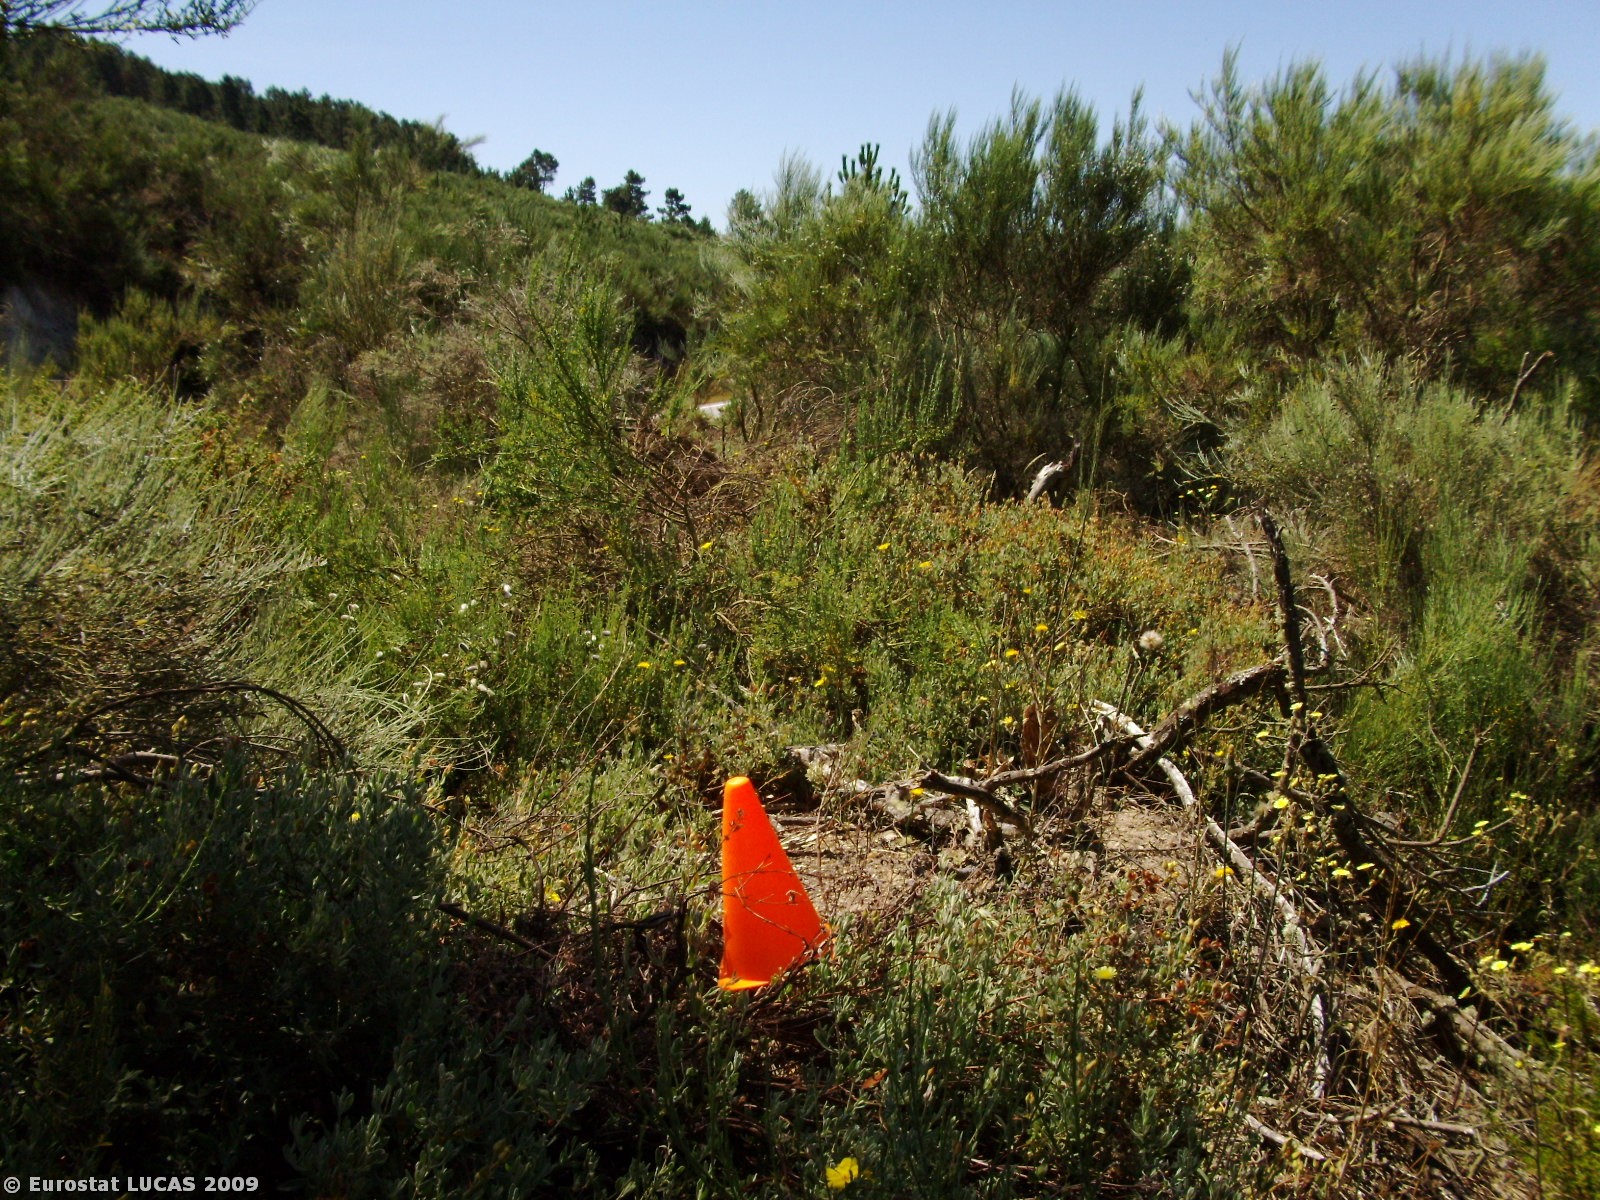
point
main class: Woodland
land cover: Coniferous woodland
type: coniferous forest of the mediterranean region
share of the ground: 25 - 50 %
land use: Forestry
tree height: > 5 m
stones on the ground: < 10 %
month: July
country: PT
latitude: 40.9790
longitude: -7.7505
